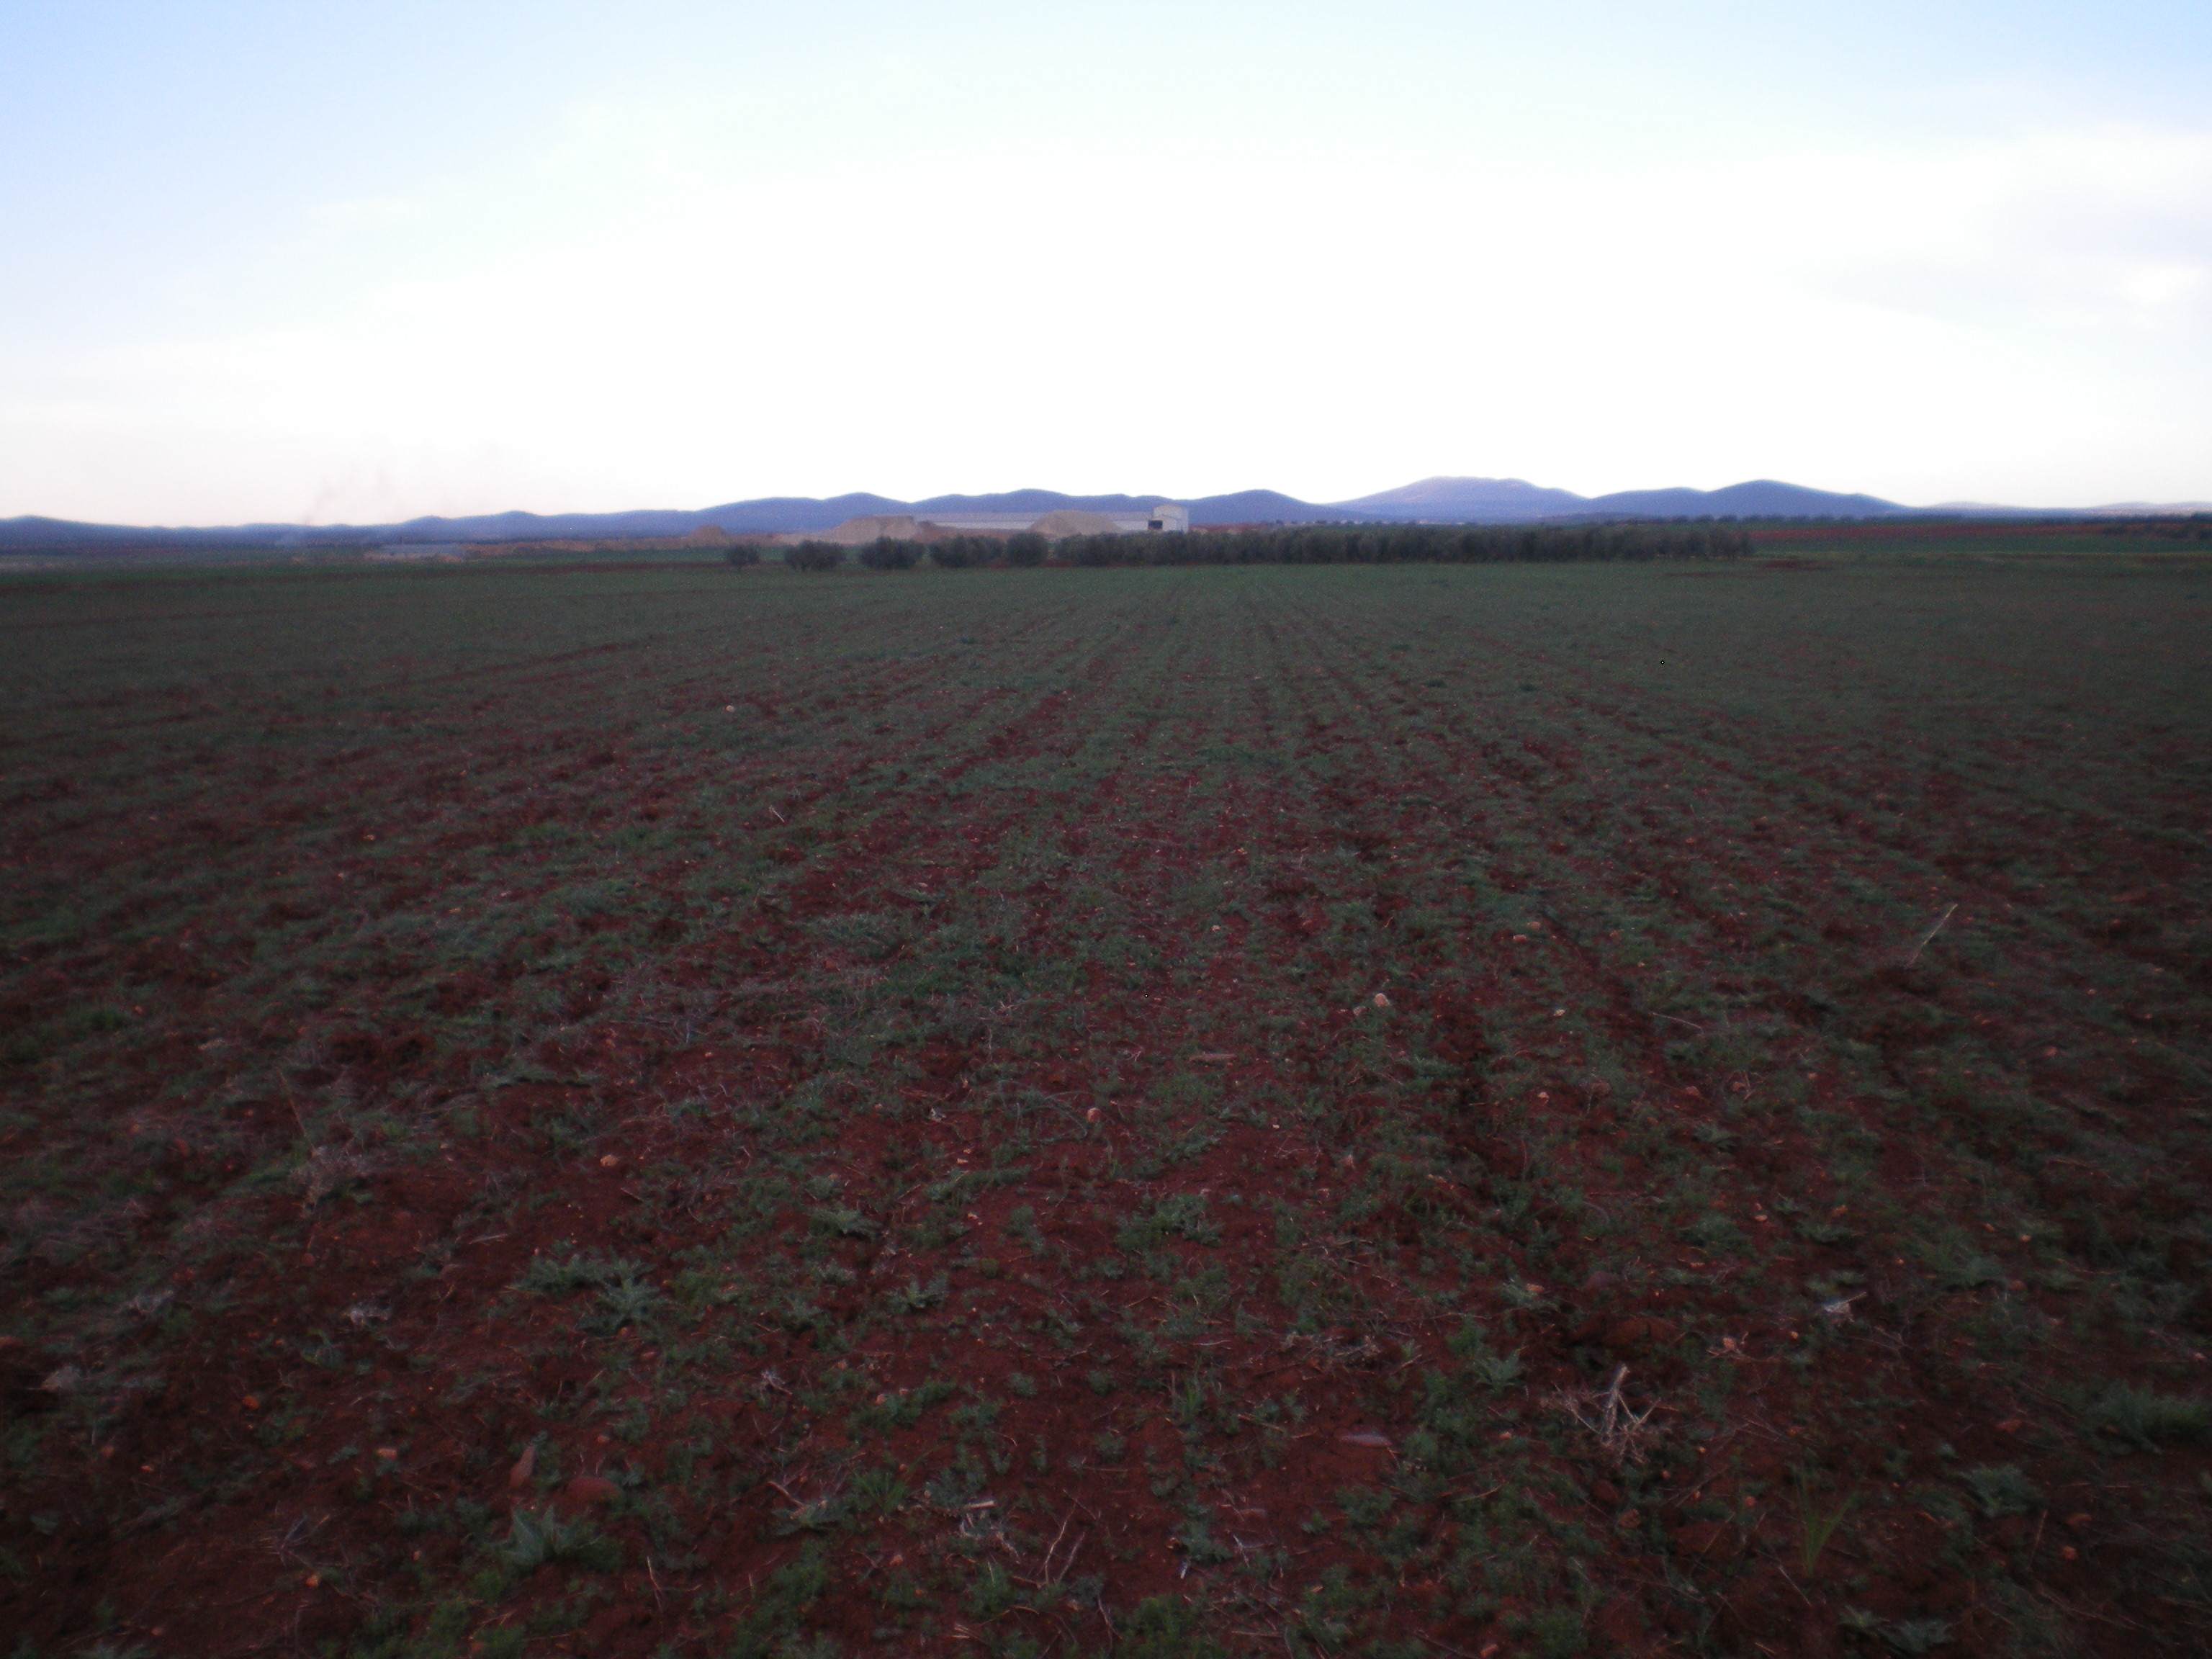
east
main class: Grassland
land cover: Spontaneously vegetated surfaces
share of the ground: > 75 %
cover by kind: unconsolidated bare surface 60 %, herbaceous plants 40 %
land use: Fallow land
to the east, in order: Spontaneously vegetated surfaces; Olive groves
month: April
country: ES
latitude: 38.6416
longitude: -3.4404
